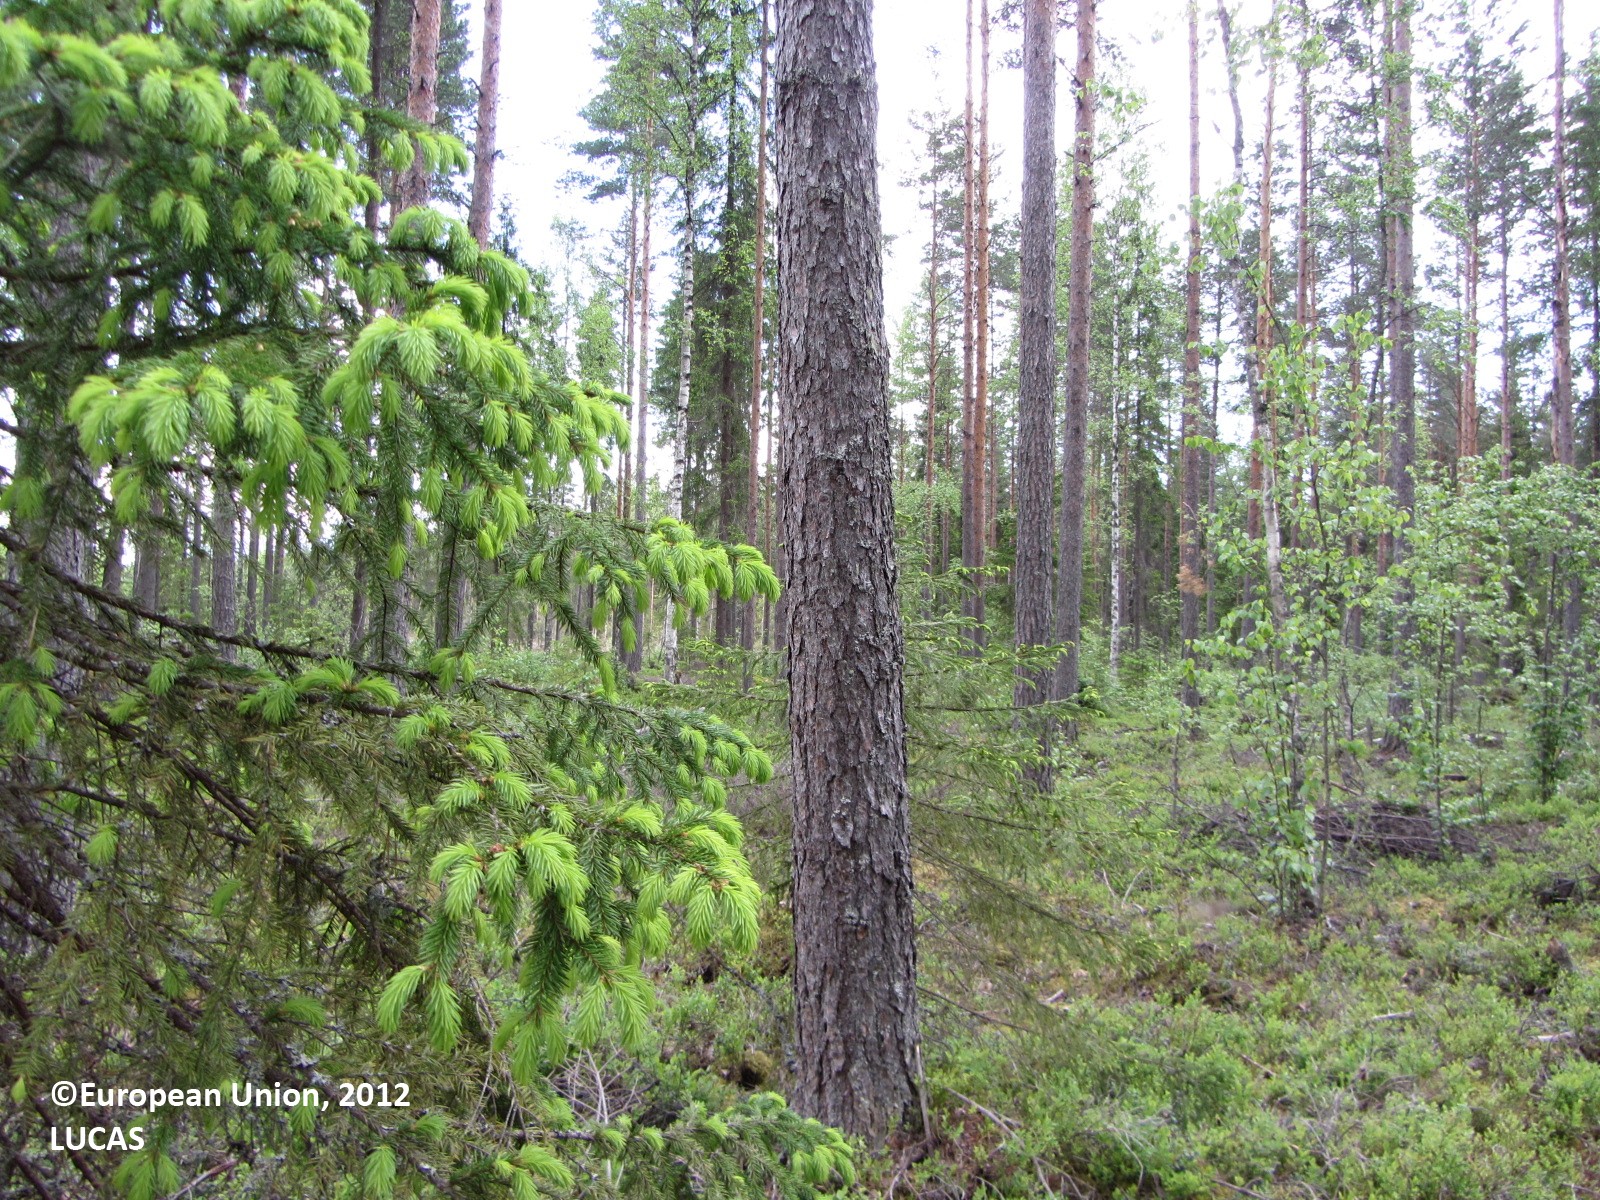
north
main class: Woodland
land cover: Pine dominated mixed woodland
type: boreal forest
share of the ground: 50 - 75 %
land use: Forestry
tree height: > 5 m
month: June
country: FI
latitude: 61.9361
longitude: 25.1033
